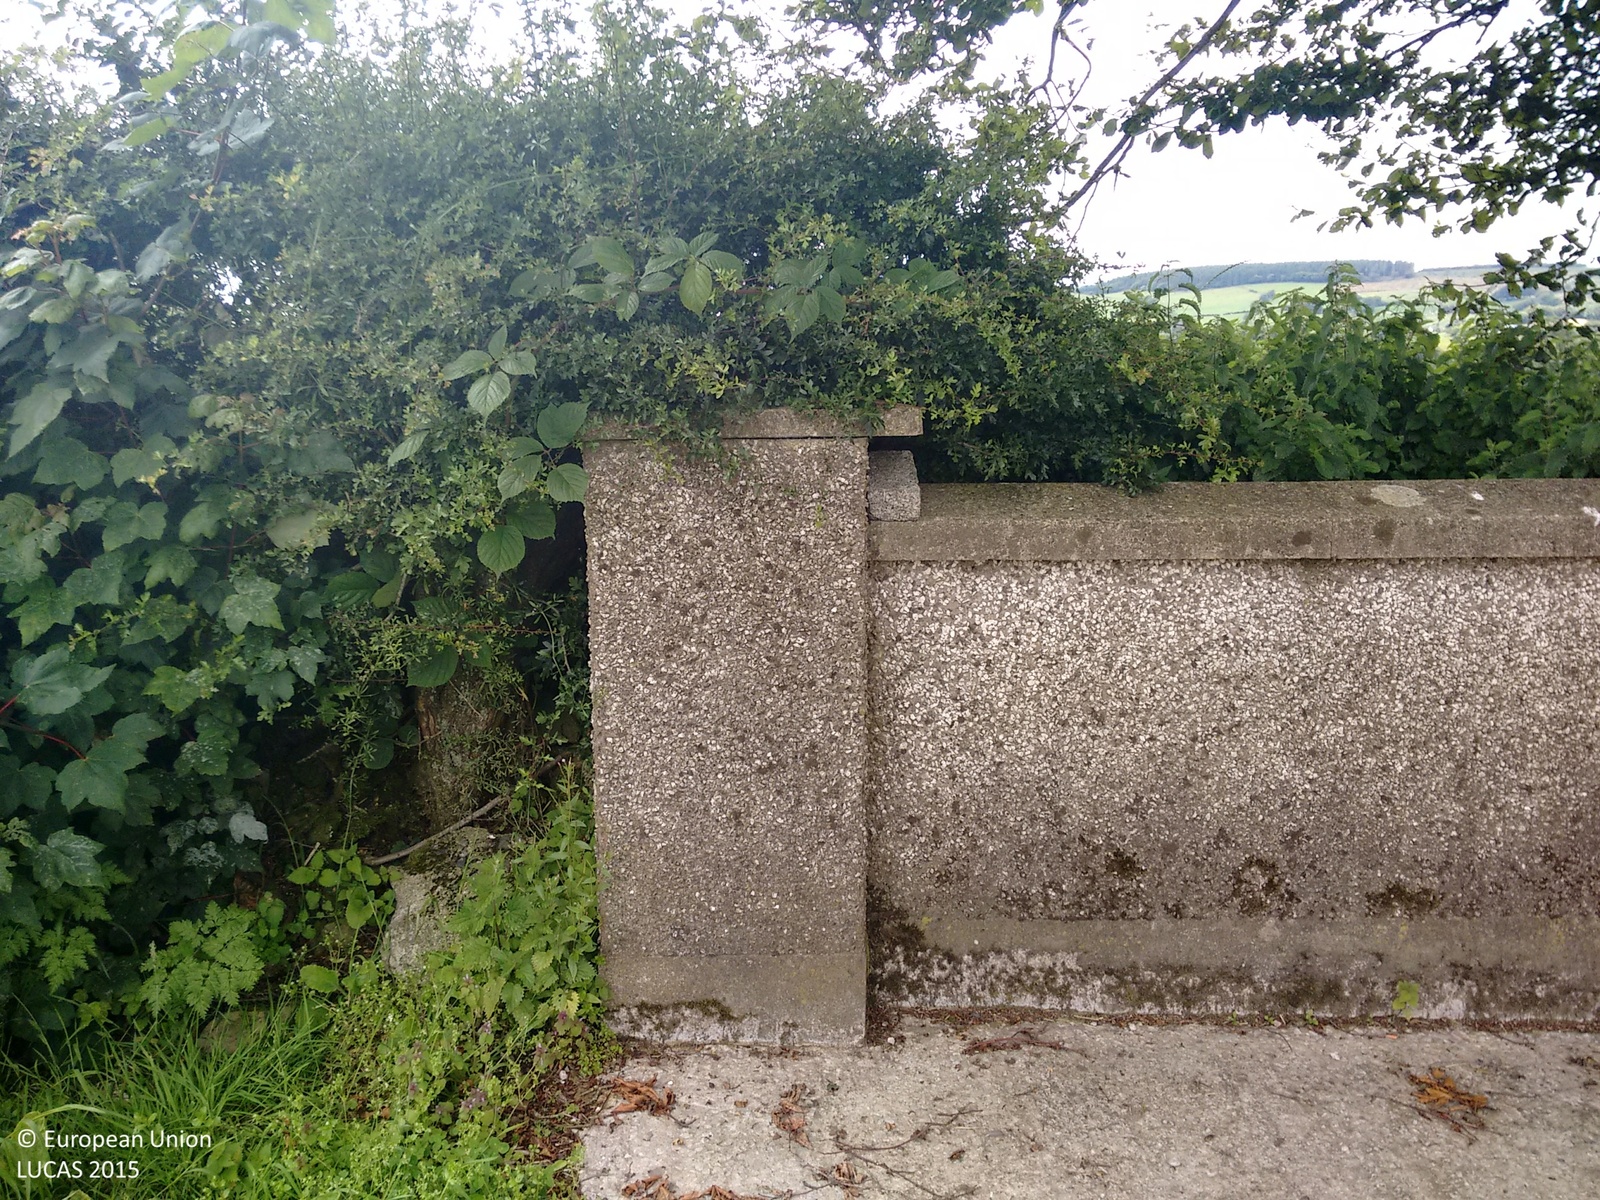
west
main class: Grassland
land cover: Grassland without tree/shrub cover
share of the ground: > 75 %
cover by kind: herbaceous plants 100 %
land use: Agriculture (excluding fallow land and kitchen gardens)
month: August
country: GB
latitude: 54.1712
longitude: -6.6271
